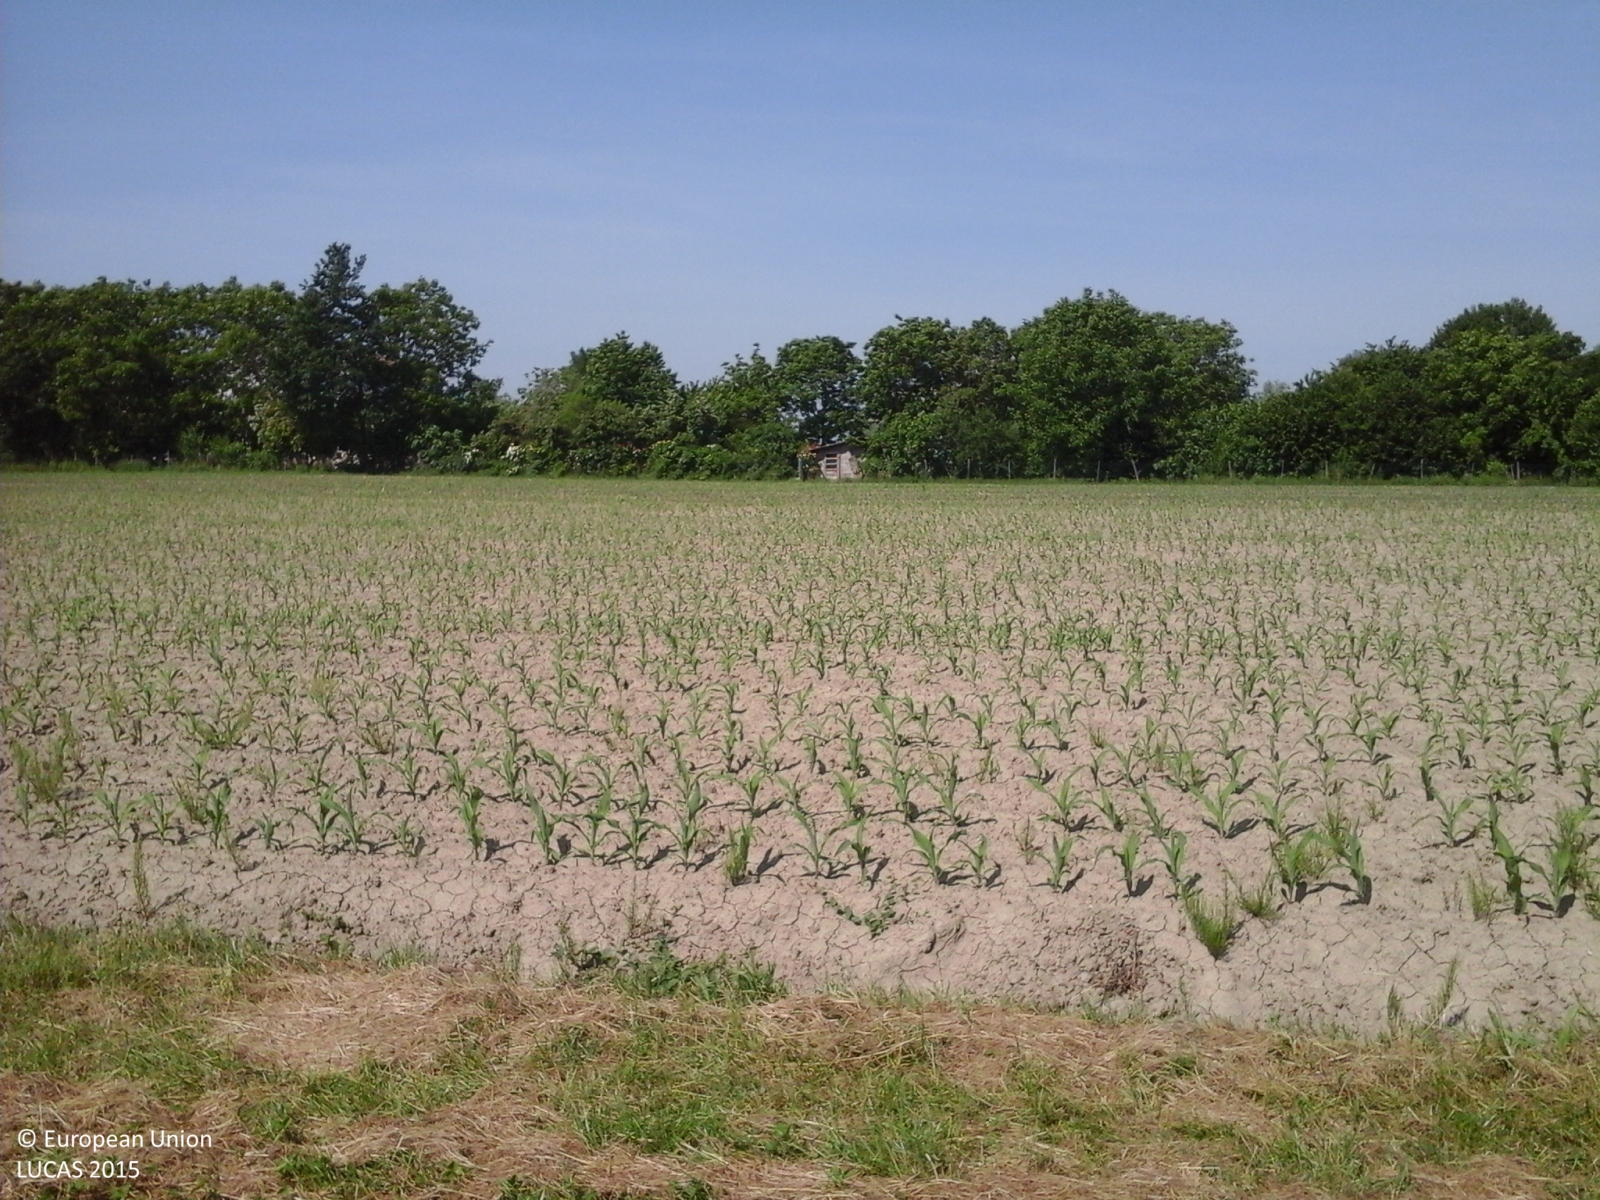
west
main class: Cropland
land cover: Maize
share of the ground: 10 - 25 %
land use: Agriculture (excluding fallow land and kitchen gardens)
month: May
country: IT
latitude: 44.9253
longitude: 10.6954
